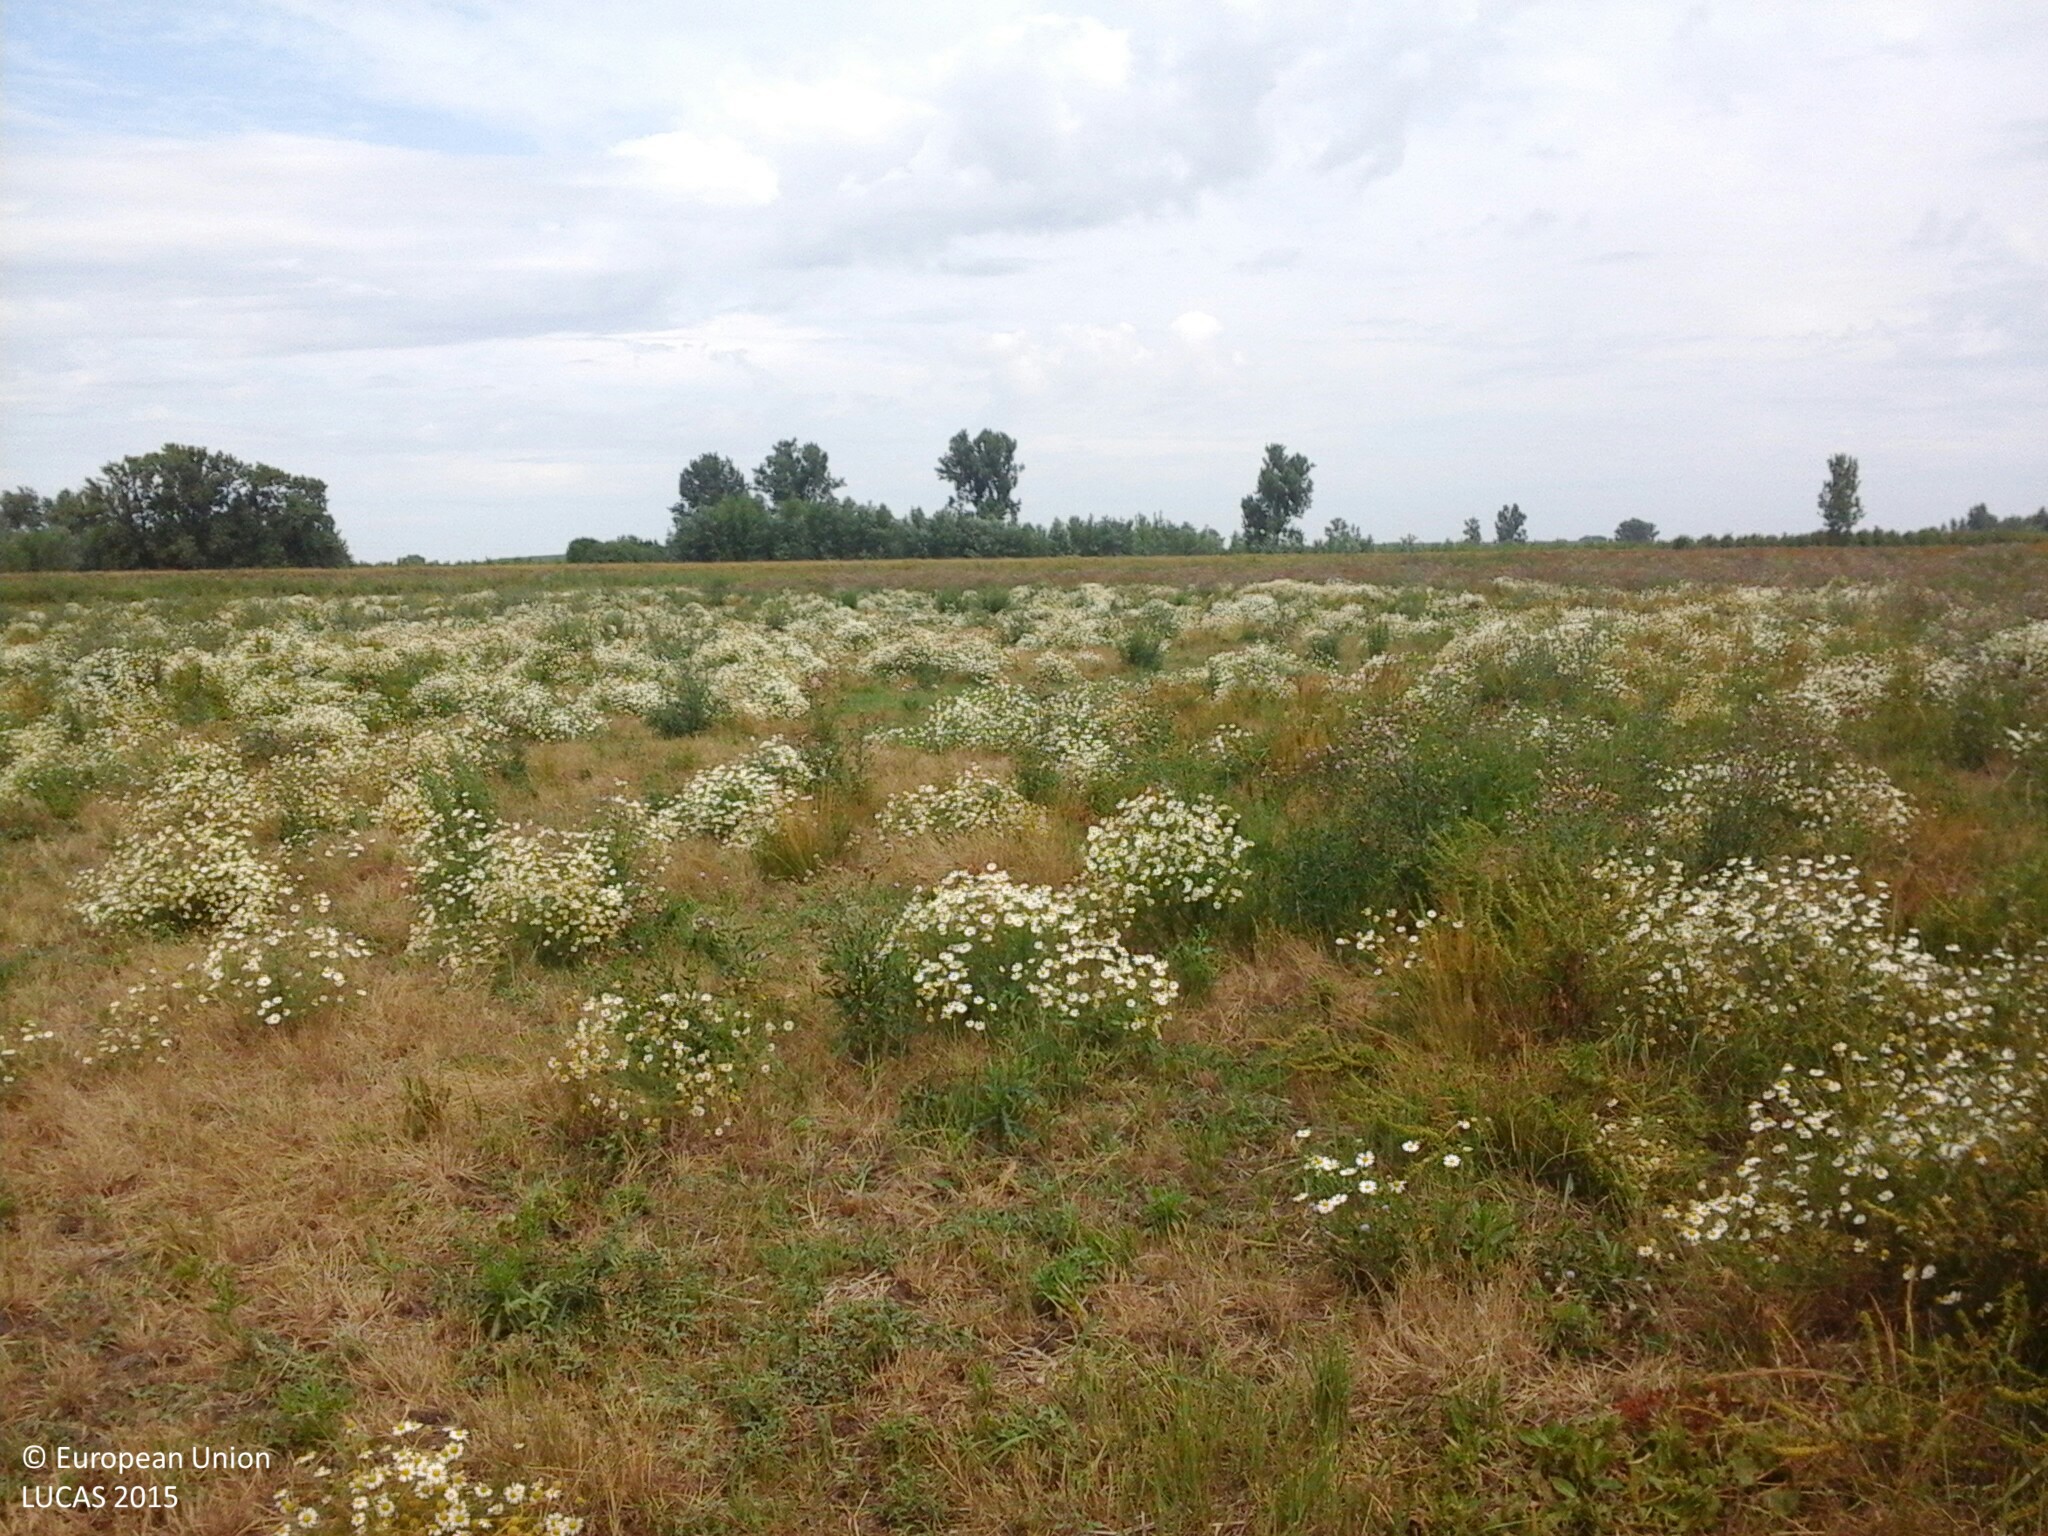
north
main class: Grassland
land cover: Spontaneously vegetated surfaces
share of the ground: > 75 %
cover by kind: herbaceous plants 100 %
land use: Semi-natural and natural areas not in use
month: July
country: HU
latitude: 48.2739
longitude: 21.8406
